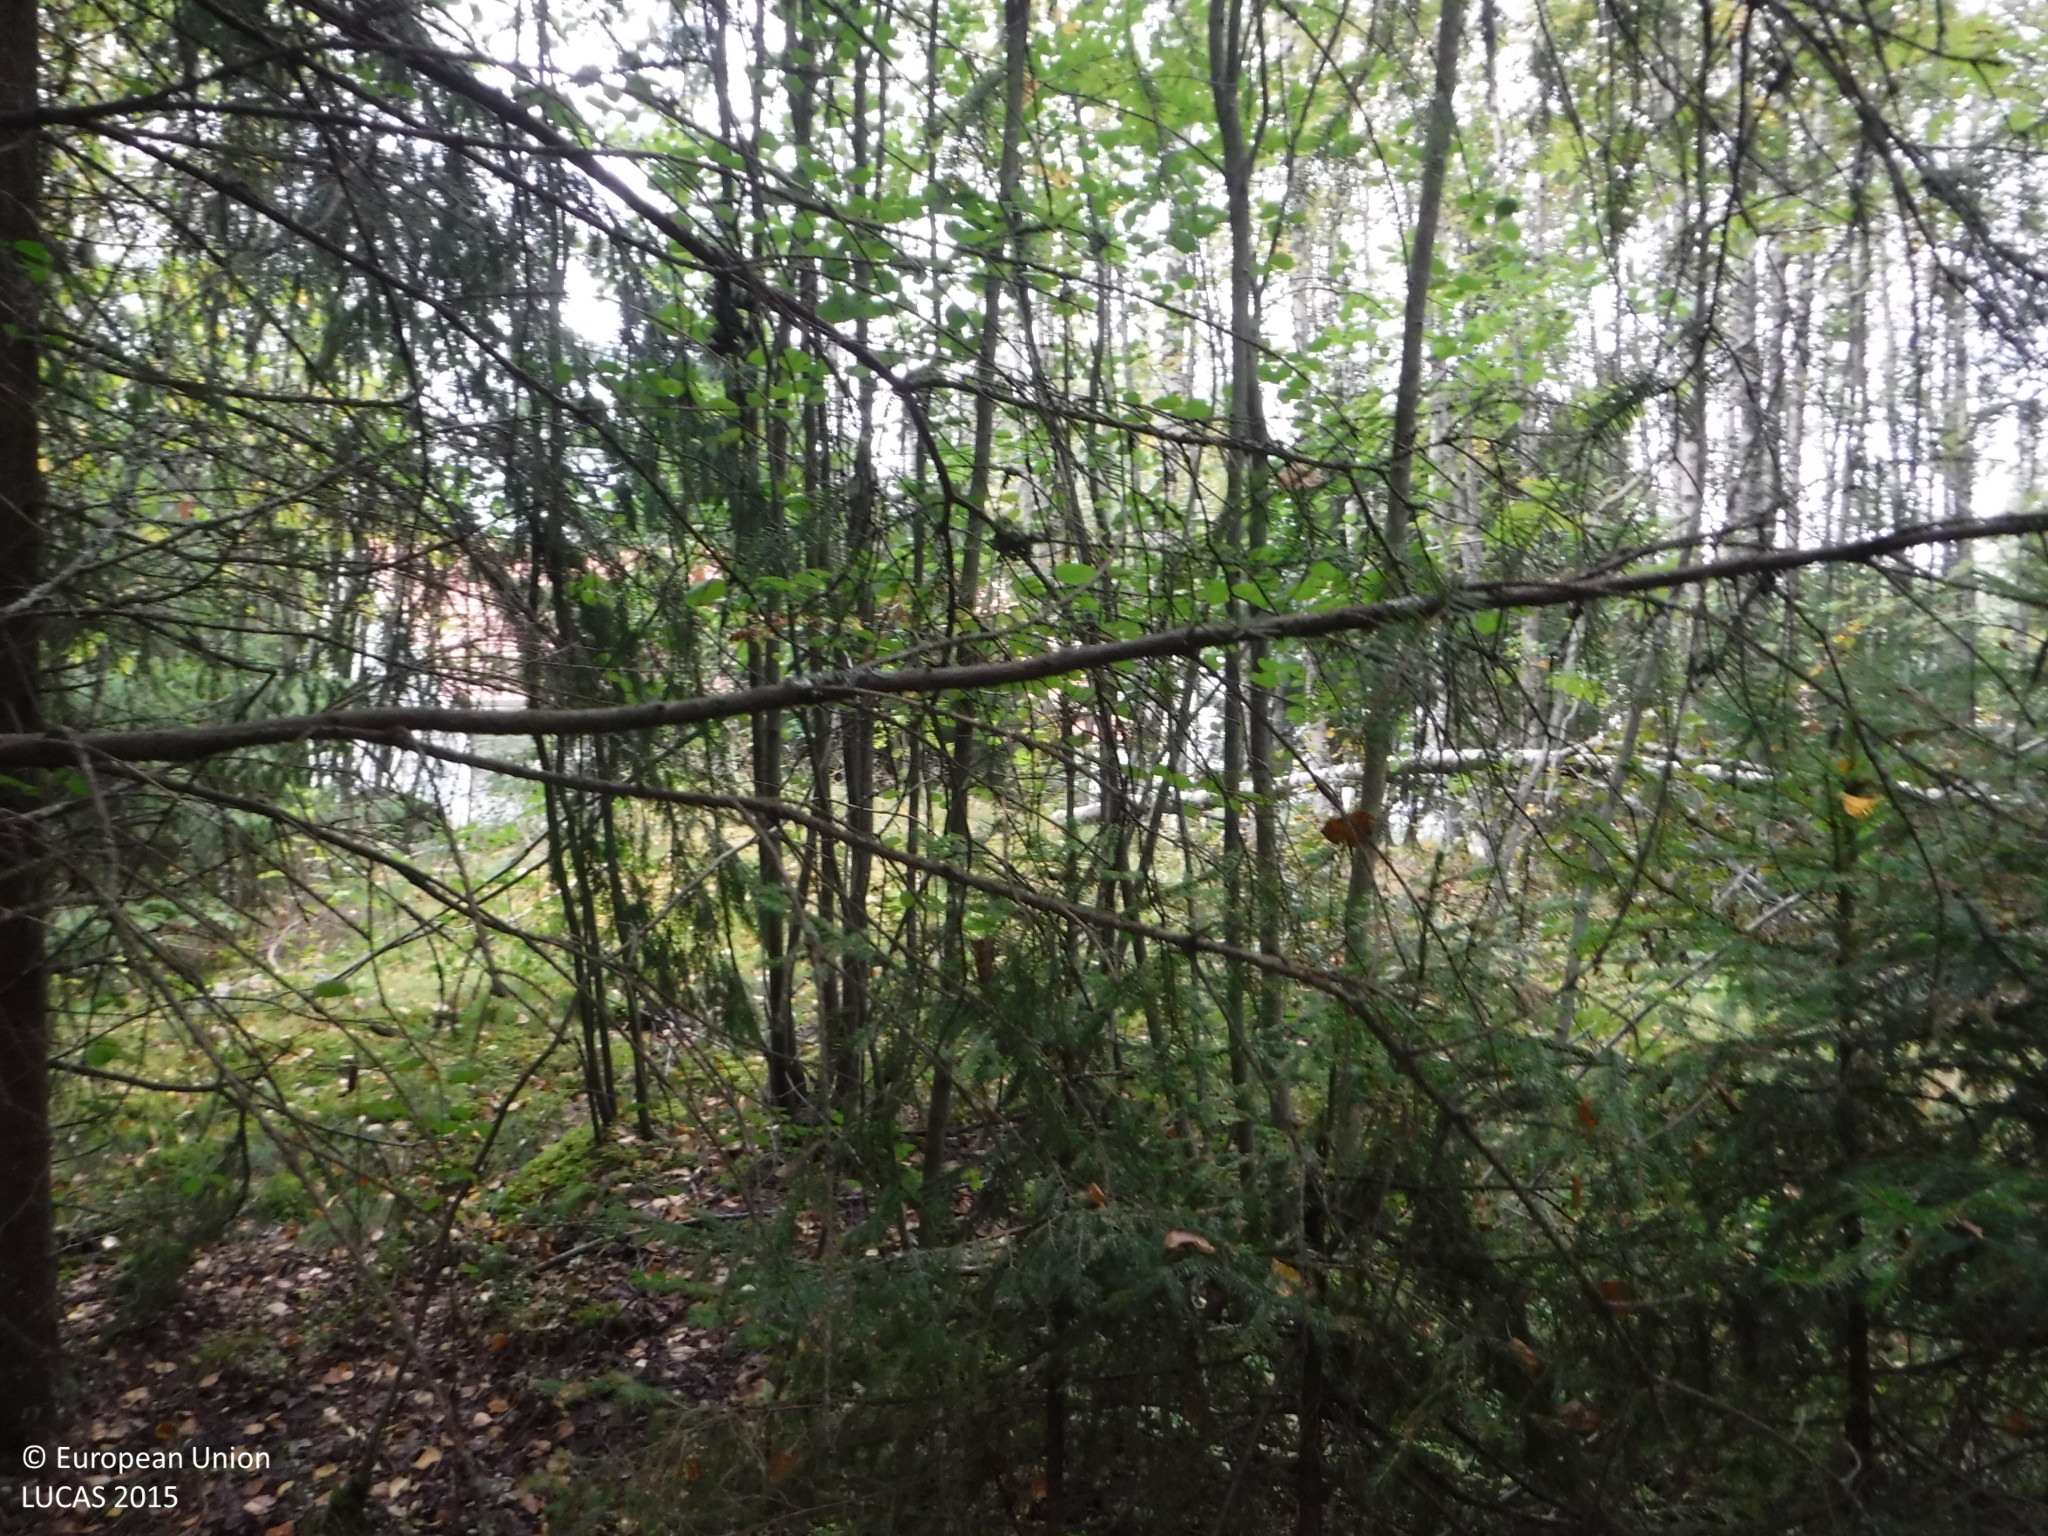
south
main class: Woodland
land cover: Spruce dominated mixed woodland
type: boreal forest
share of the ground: > 75 %
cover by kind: coniferous forest trees 45 %, broadleaved forest trees 30 %, shrubs 20 %, lichens and mosses 5 %
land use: Forestry
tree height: > 5 m
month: September
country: FI
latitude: 61.3573
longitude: 22.9185
